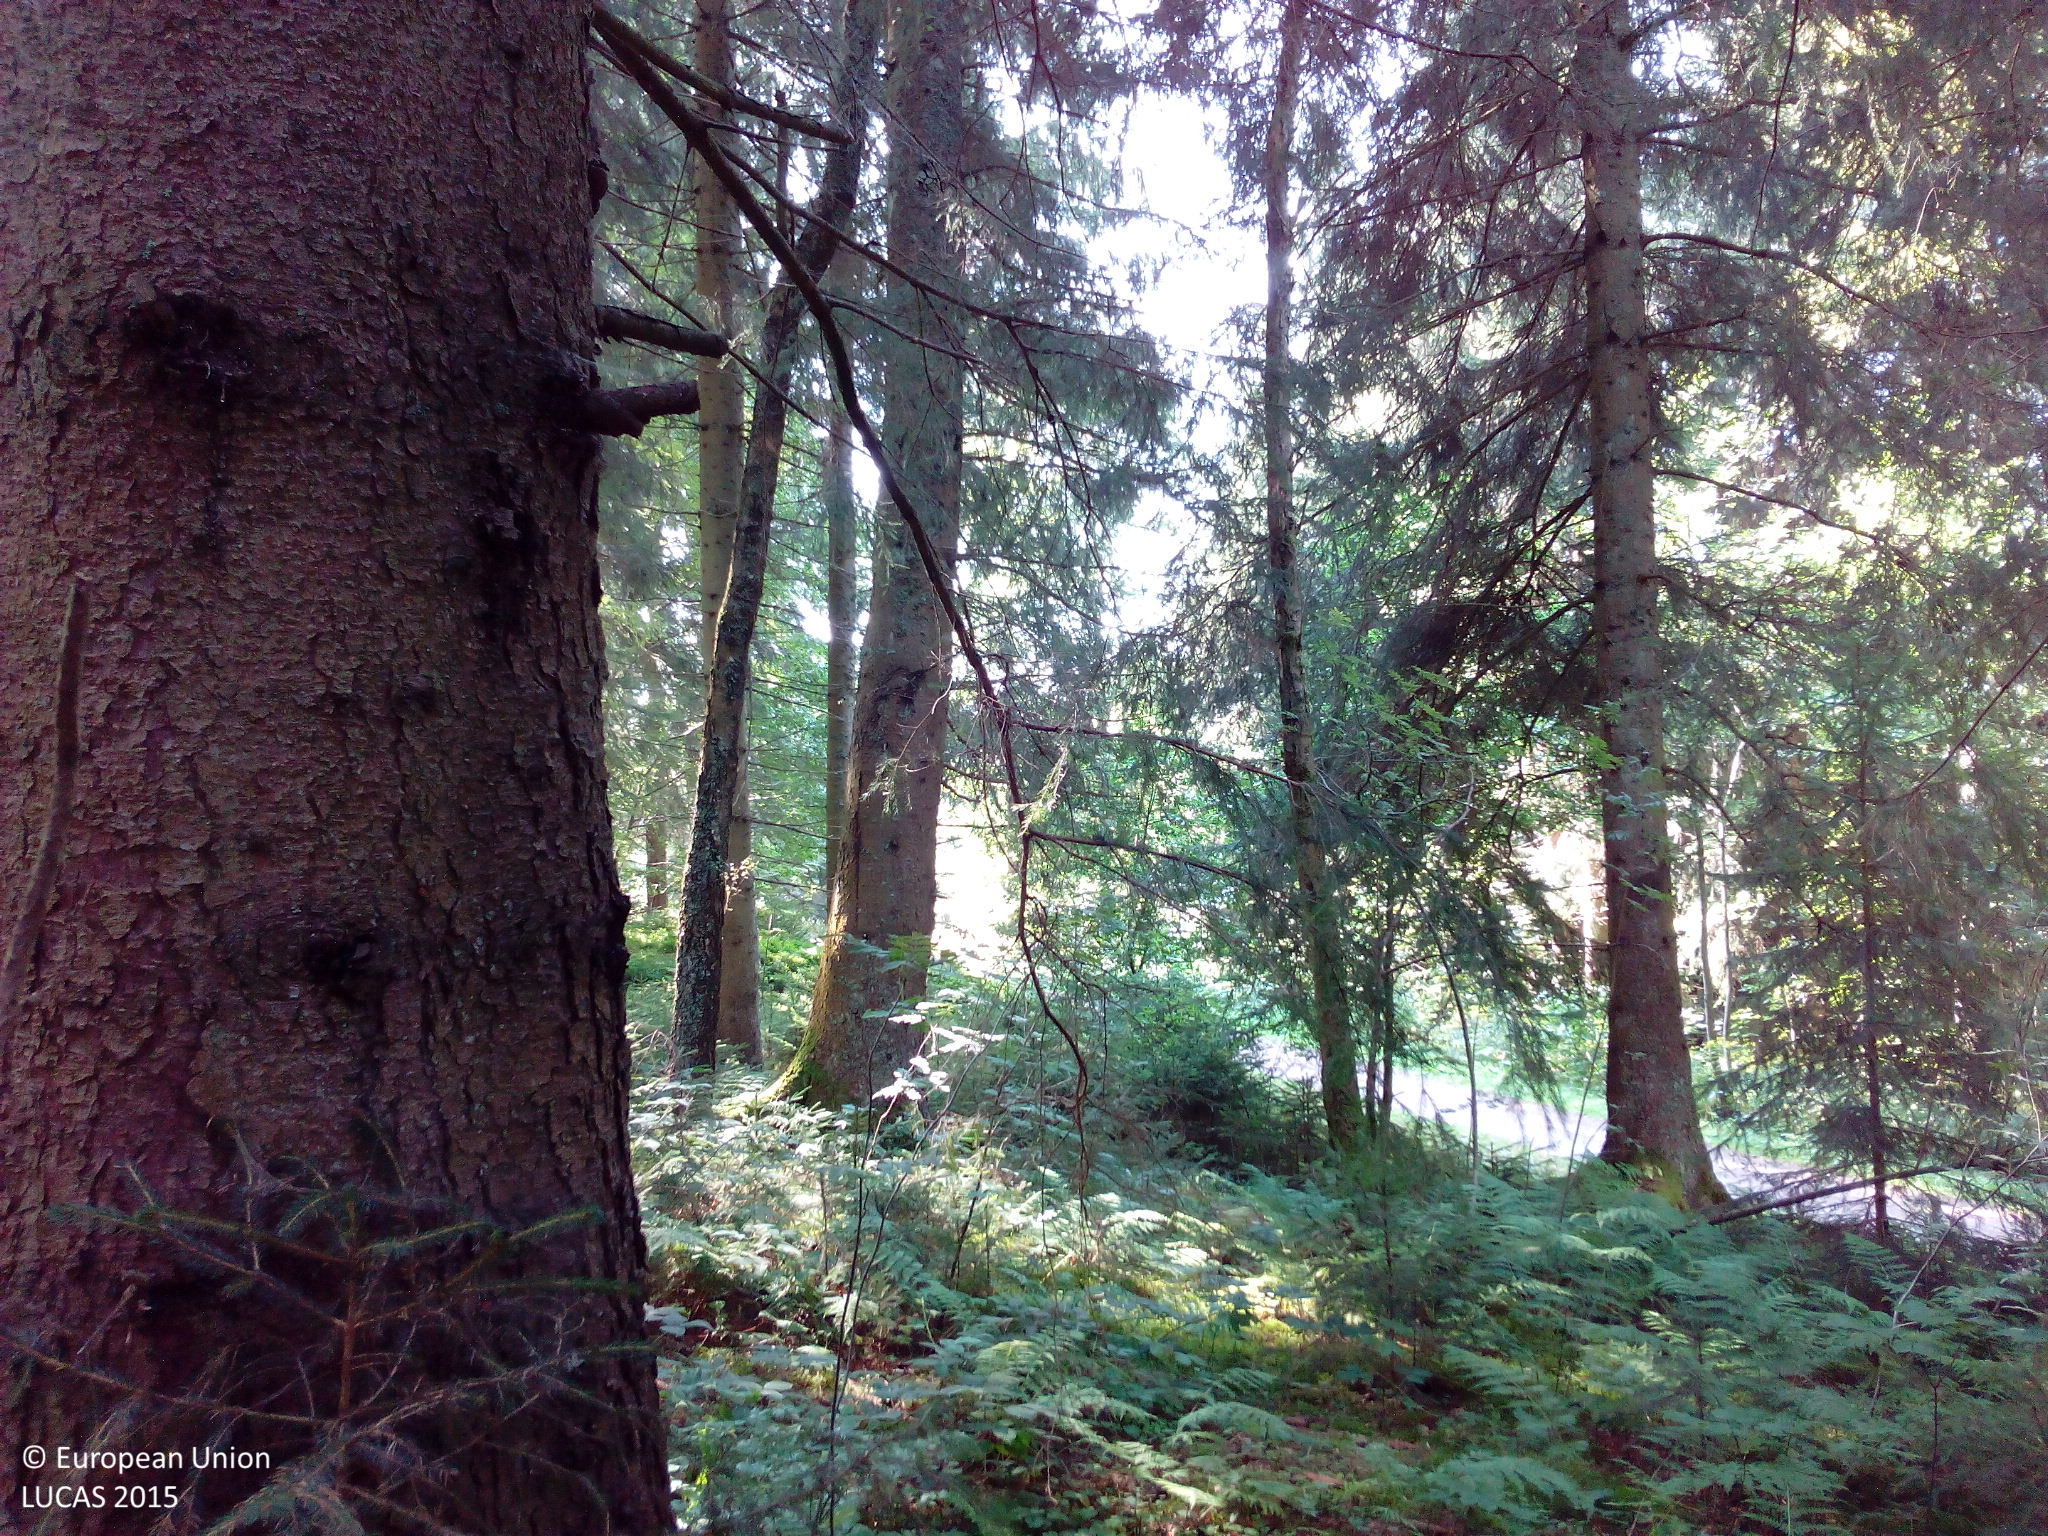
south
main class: Woodland
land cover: Spruce dominated coniferous woodland
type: hemiboreal forest and nemoral coniferous forest and mixed broadleaved-coniferous forest
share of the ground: > 75 %
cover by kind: coniferous forest trees 70 %, broadleaved forest trees 10 %, herbaceous plants 10 %, lichens and mosses 5 %, unconsolidated bare surface 5 %
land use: Forestry
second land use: Amenities, museums, leisure
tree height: > 5 m
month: August
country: DE
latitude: 47.8299
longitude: 8.1443
